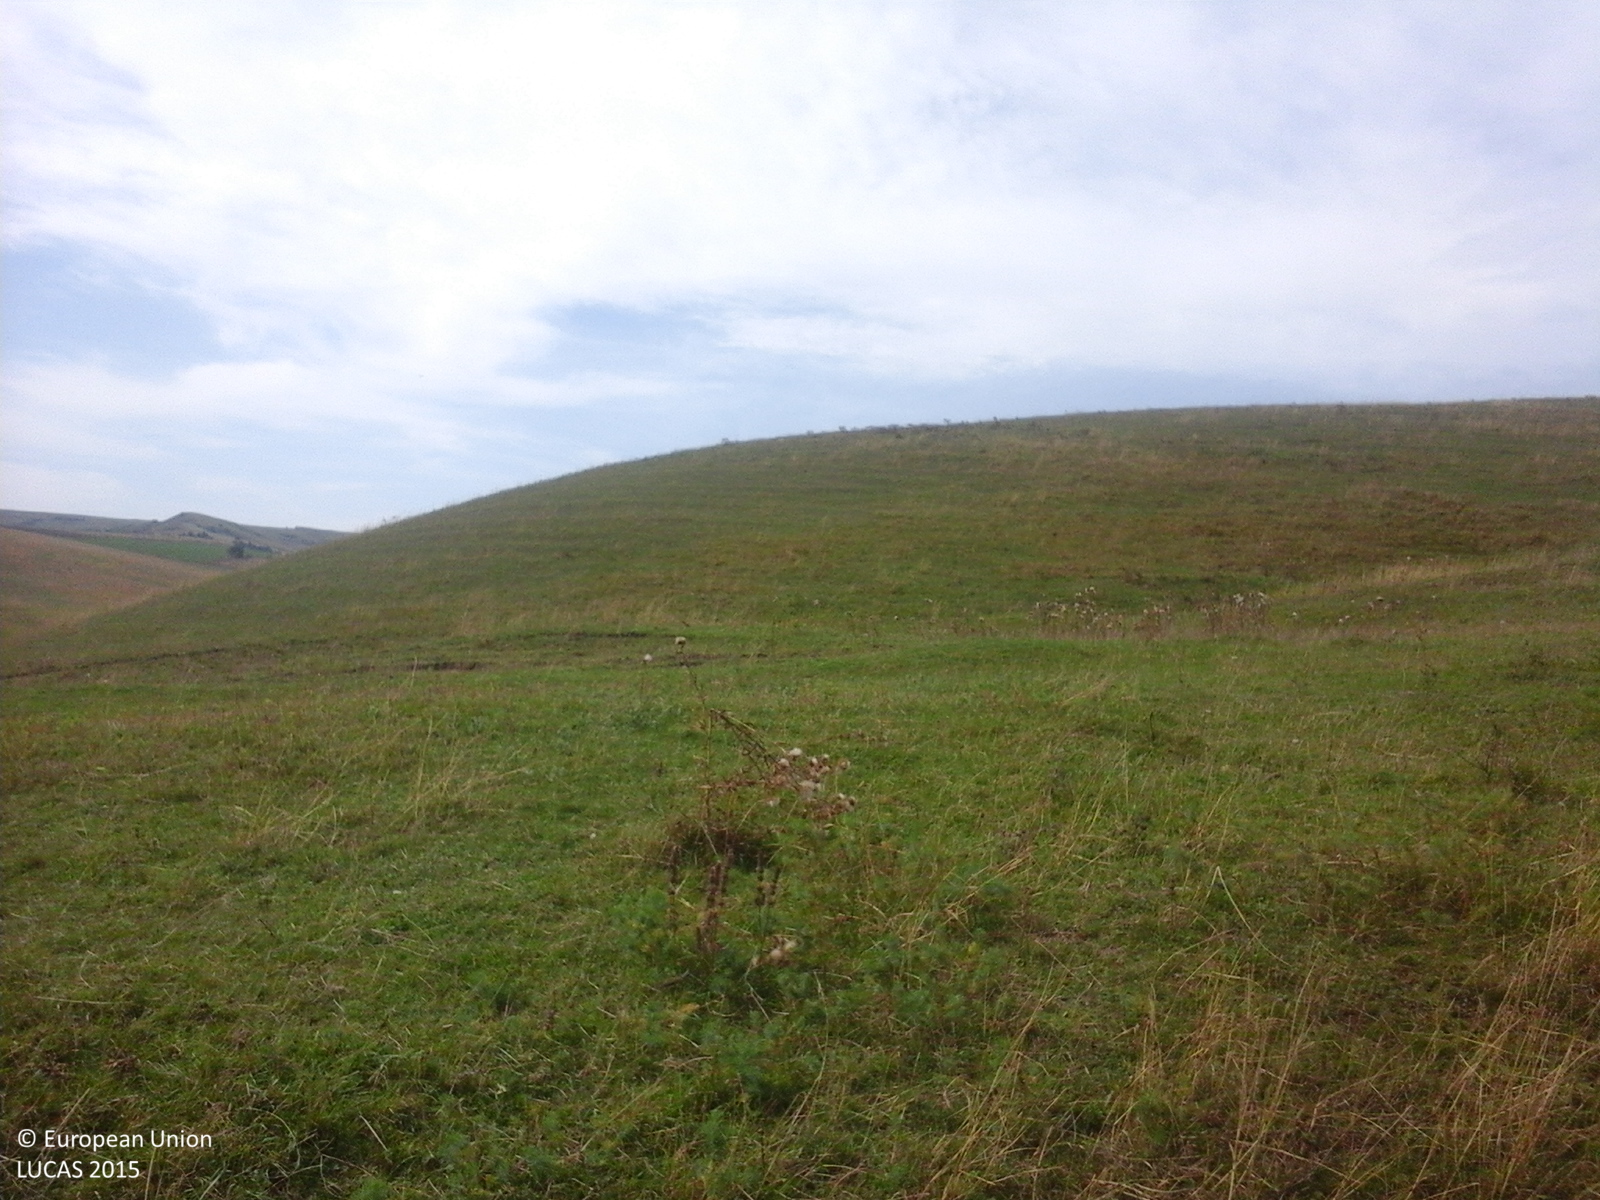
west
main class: Grassland
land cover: Grassland without tree/shrub cover
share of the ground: > 75 %
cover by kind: herbaceous plants 100 %
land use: Agriculture (excluding fallow land and kitchen gardens)
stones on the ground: < 10 %
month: September
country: RO
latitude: 46.7263
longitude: 23.8270
